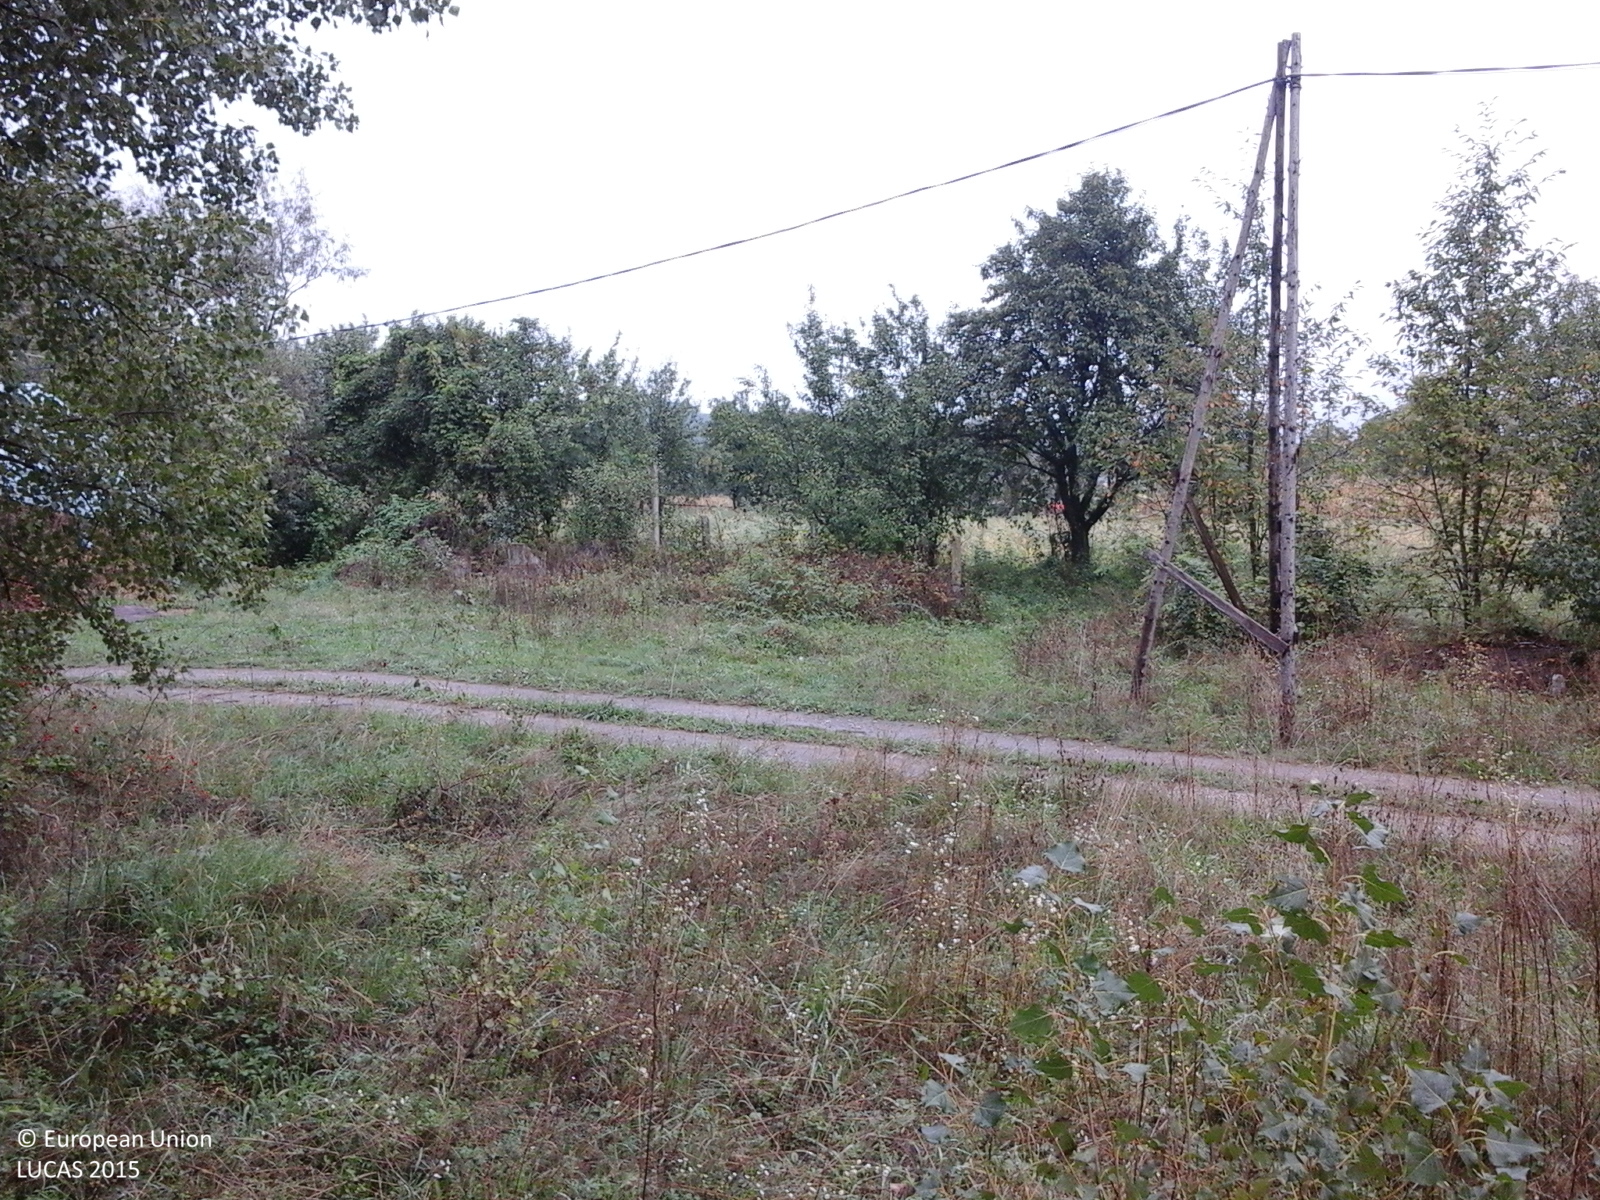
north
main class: Woodland
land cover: Broadleaved woodland
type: exotic forest
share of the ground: > 75 %
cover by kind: broadleaved forest trees 100 %
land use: Forestry
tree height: > 5 m
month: September
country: RO
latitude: 47.0157
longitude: 22.5123
